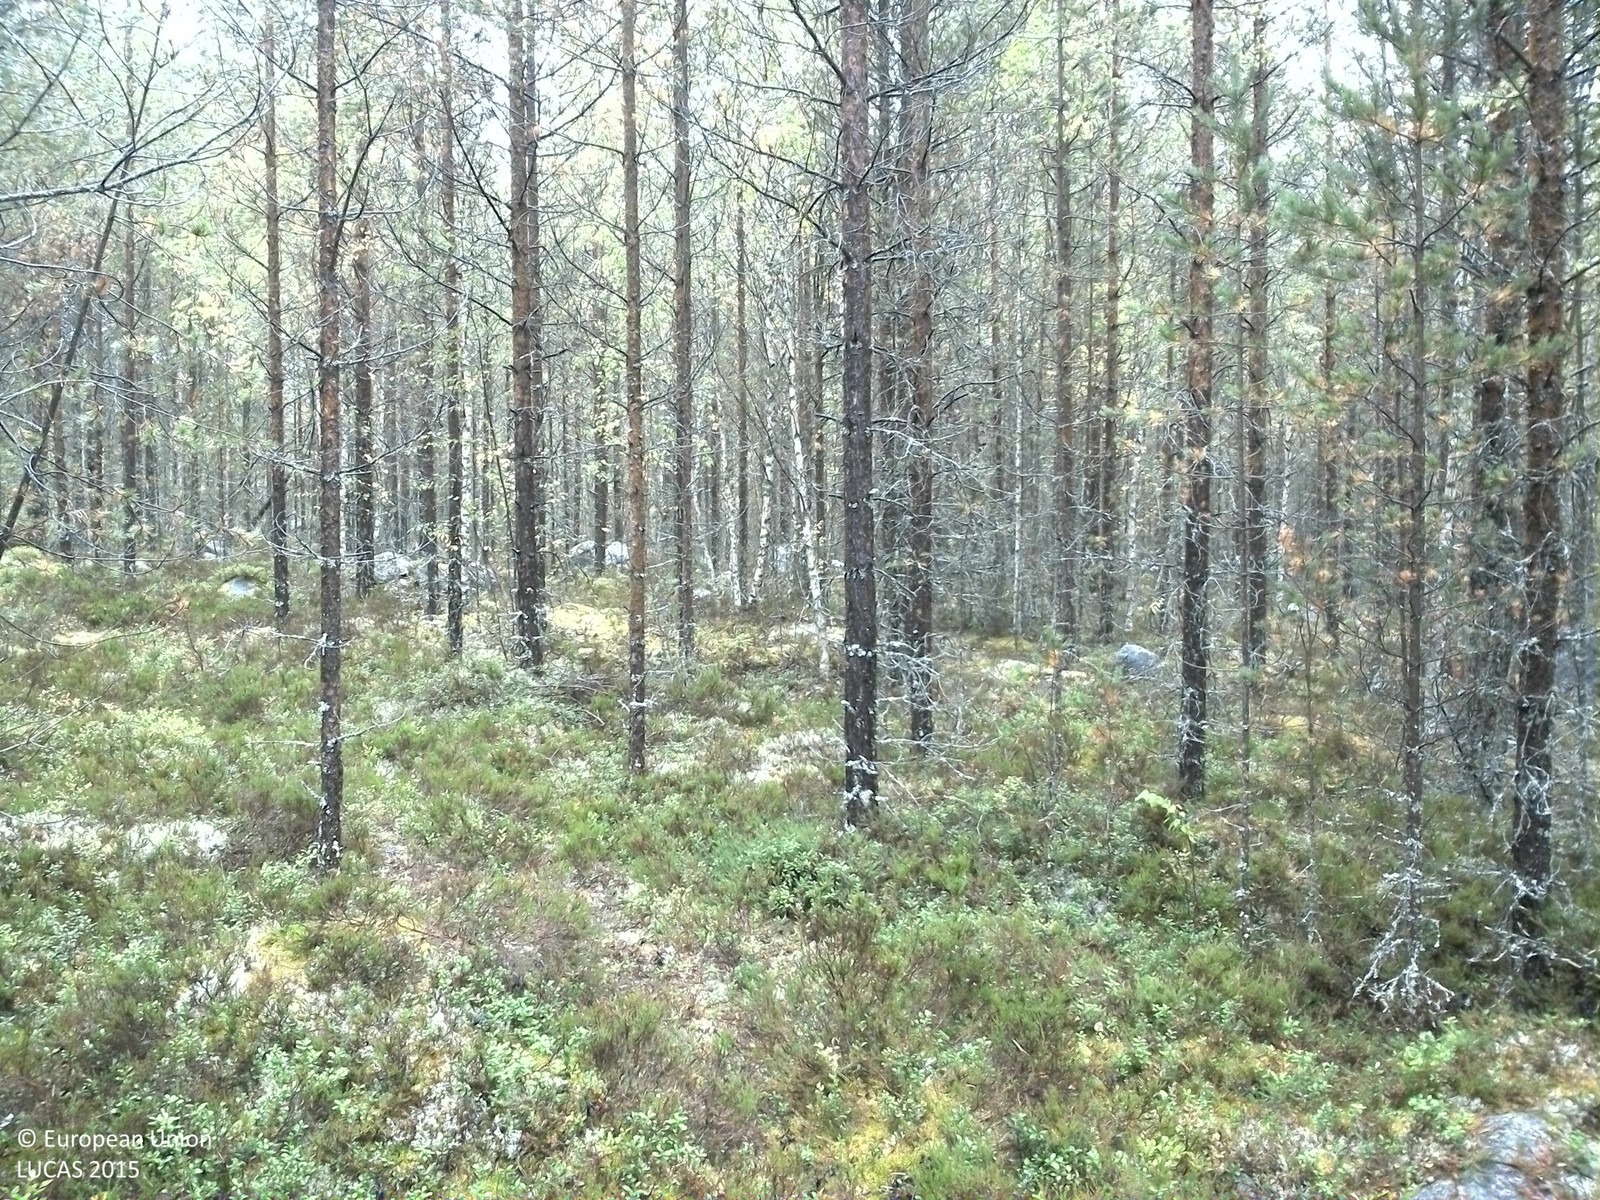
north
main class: Woodland
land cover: Pine dominated coniferous woodland
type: boreal forest
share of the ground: > 75 %
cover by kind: coniferous forest trees 75 %, shrubs 10 %, lichens and mosses 10 %, broadleaved forest trees 5 %
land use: Forestry
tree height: > 5 m
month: September
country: SE
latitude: 61.5126
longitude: 15.1526
